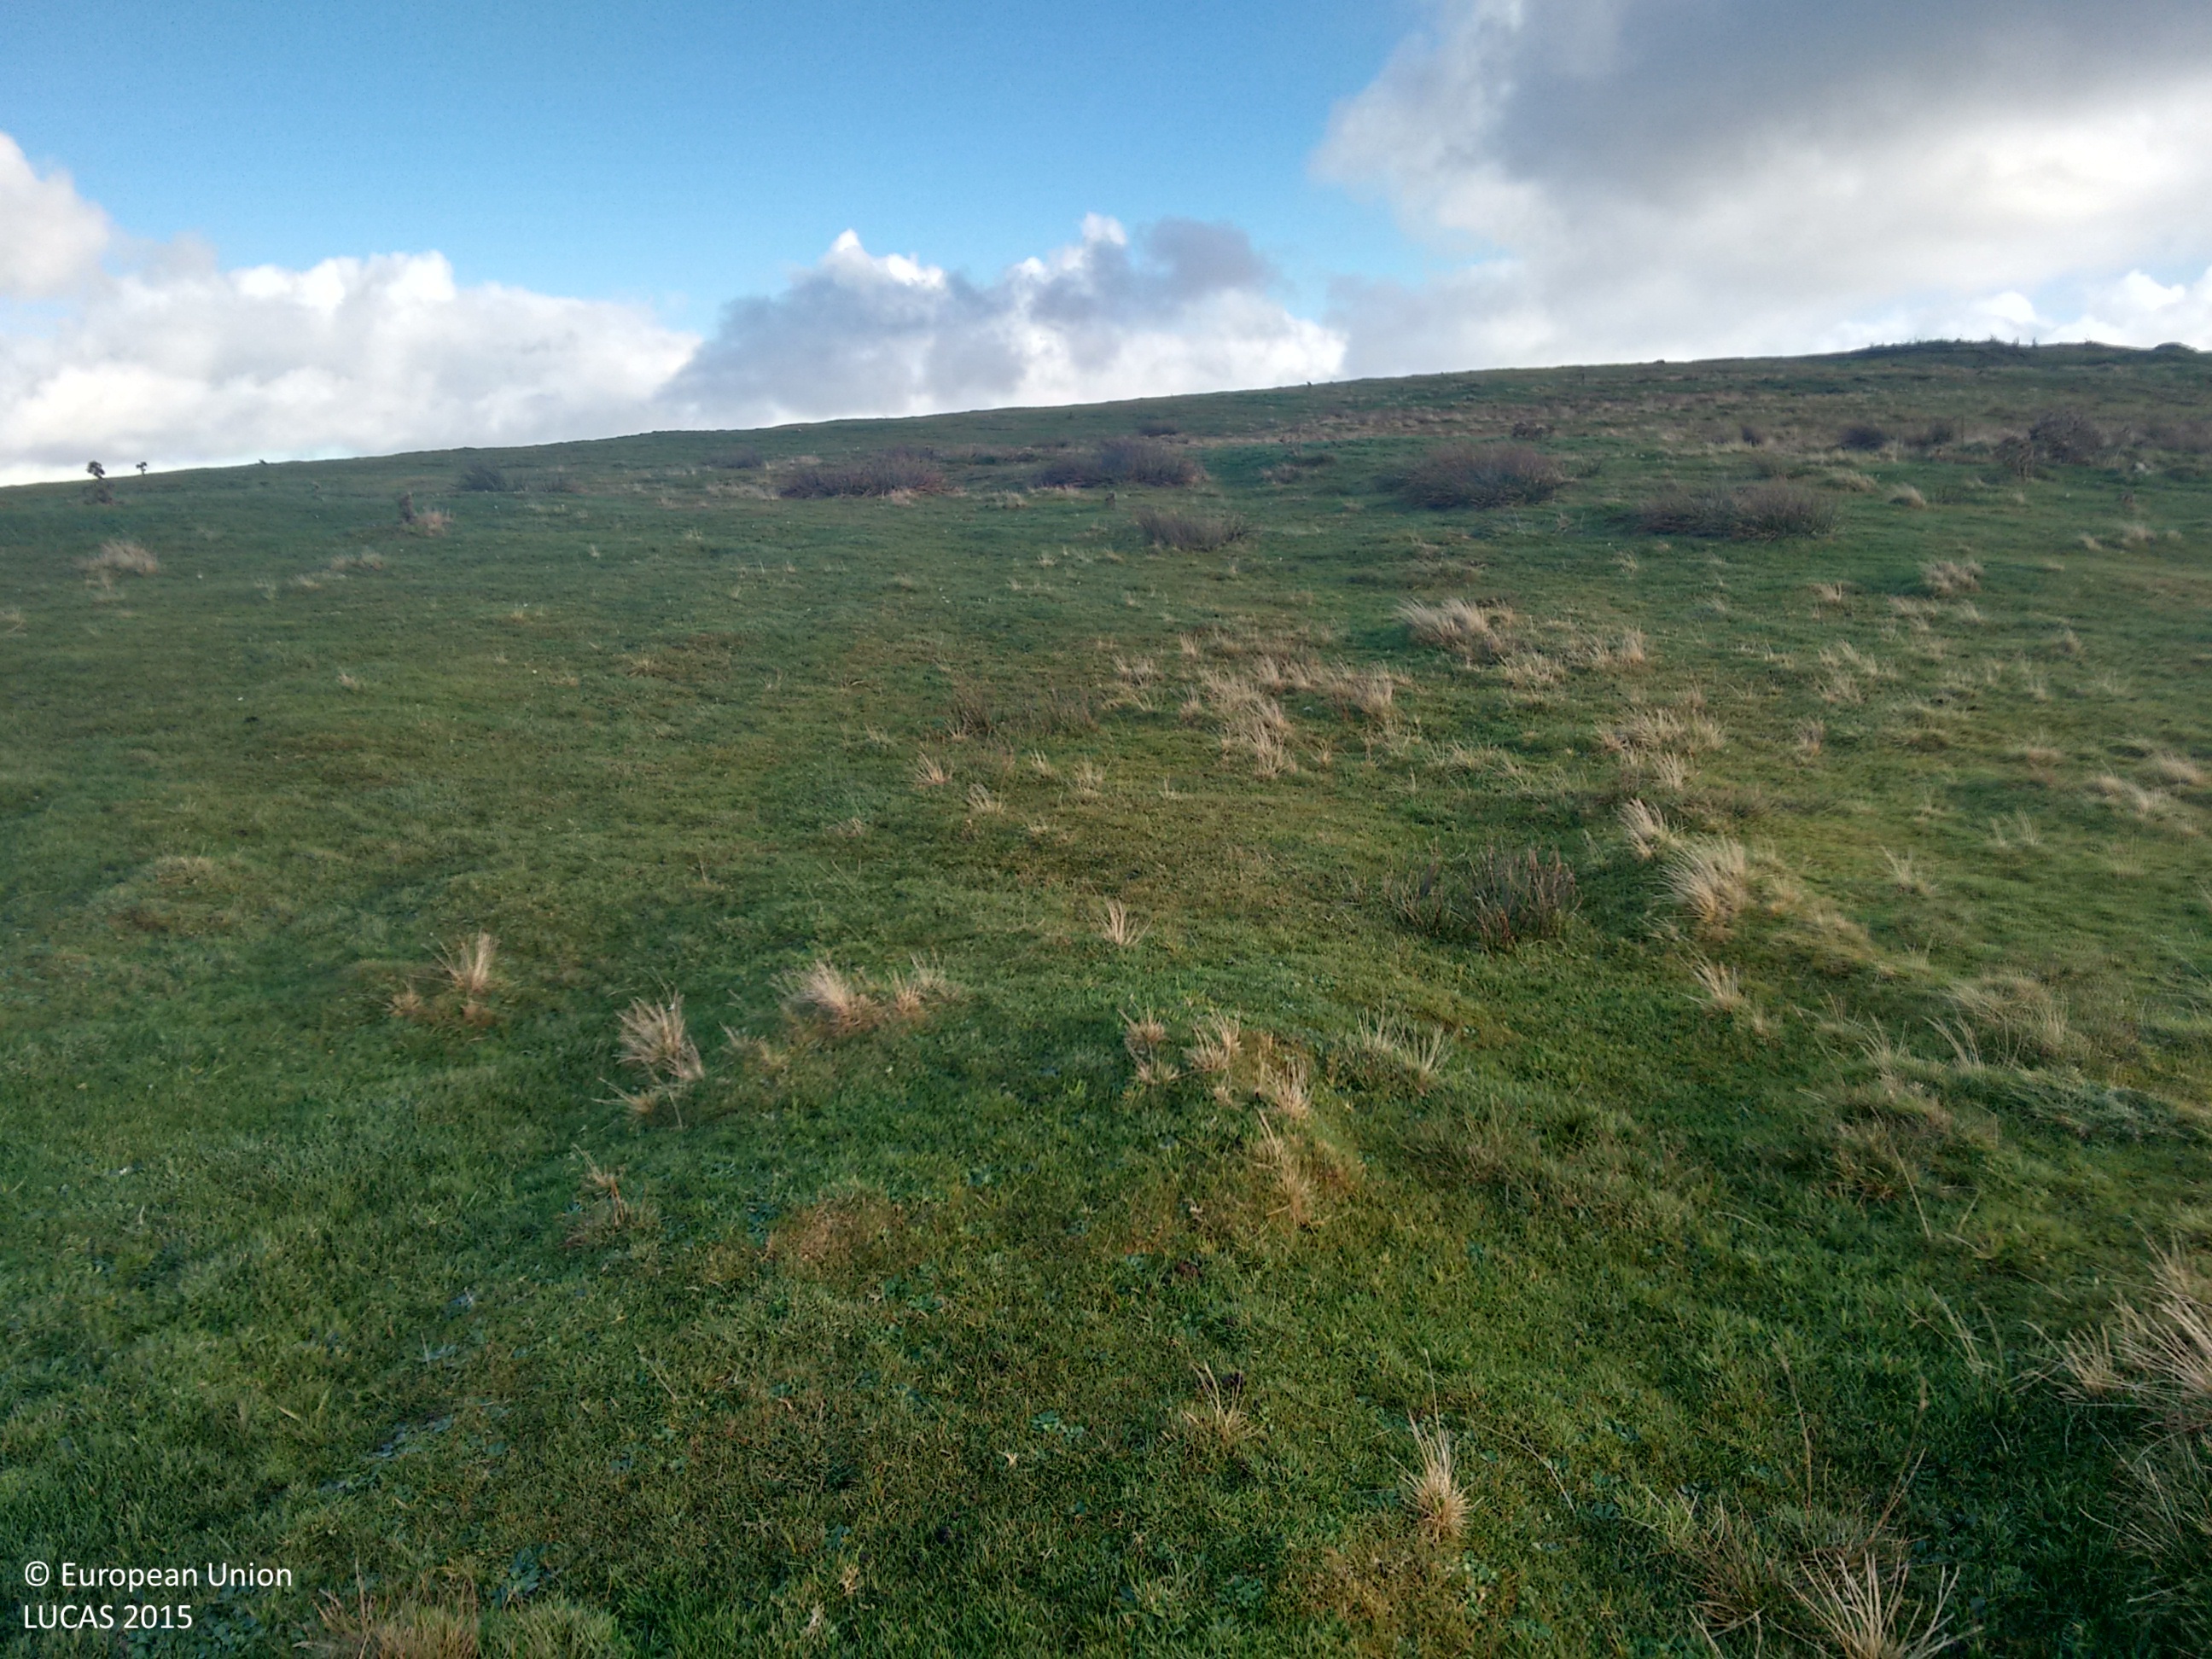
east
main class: Grassland
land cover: Grassland without tree/shrub cover
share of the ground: > 75 %
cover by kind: herbaceous plants 100 %
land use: Agriculture (excluding fallow land and kitchen gardens)
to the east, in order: Grassland without tree/shrub cover; Fences; Shrubland without tree cover
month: November
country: GB
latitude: 58.9946
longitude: -3.3382
